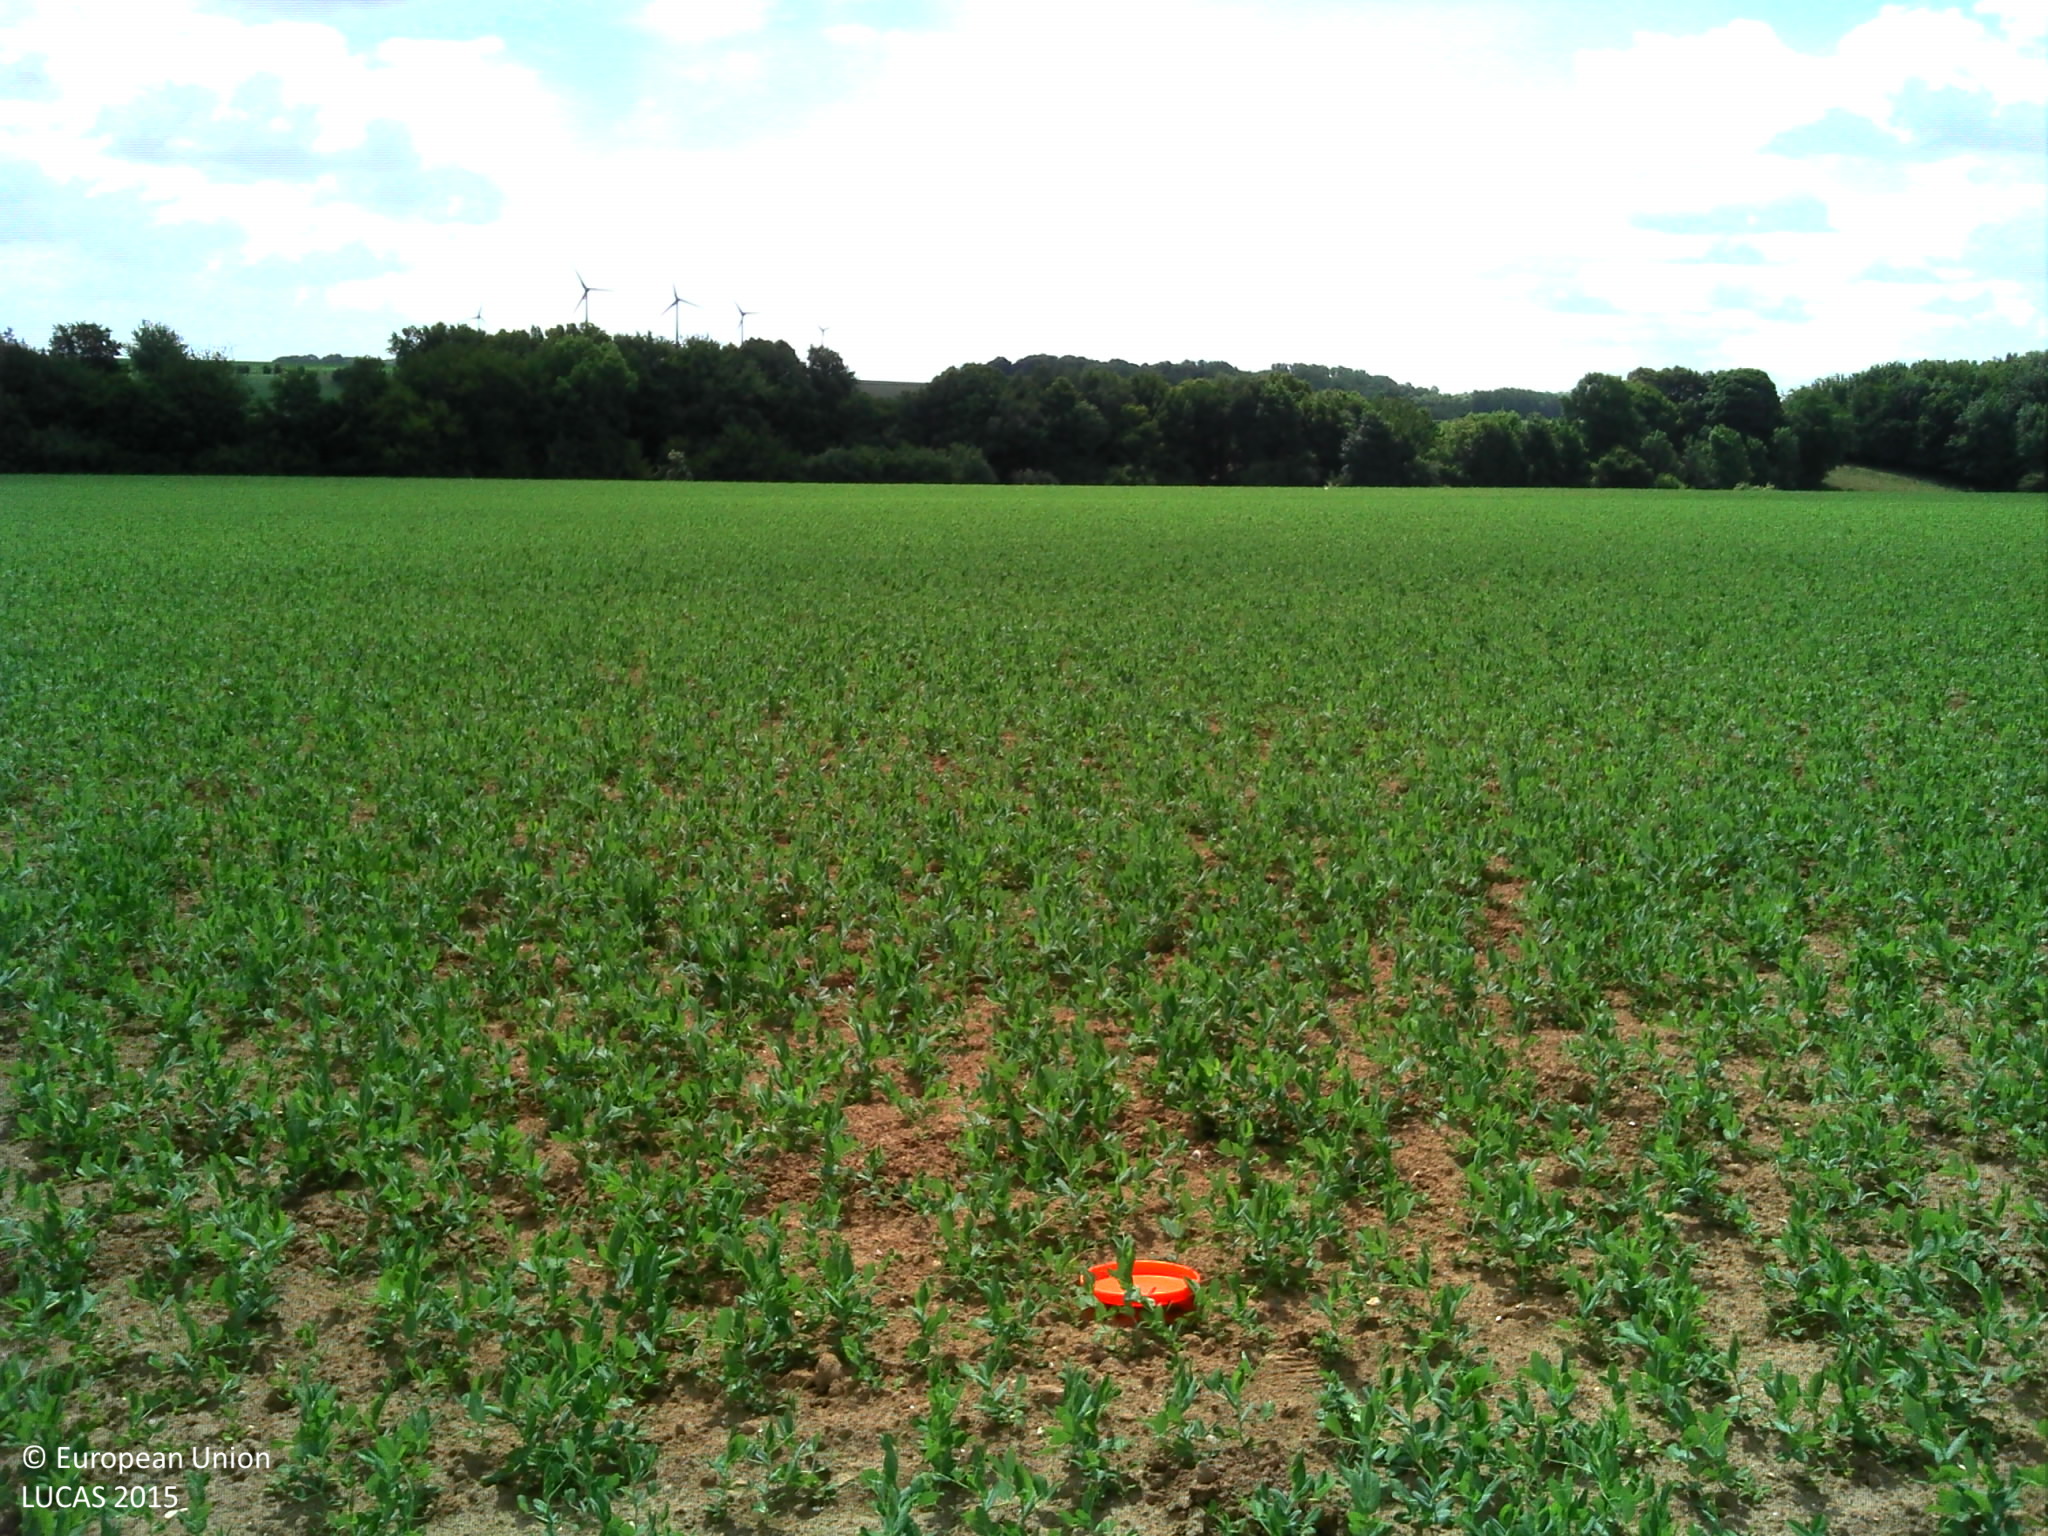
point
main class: Cropland
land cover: Other fresh vegetables
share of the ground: 50 - 75 %
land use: Agriculture (excluding fallow land and kitchen gardens)
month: June
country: FR
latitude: 50.3627
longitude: 2.3816
